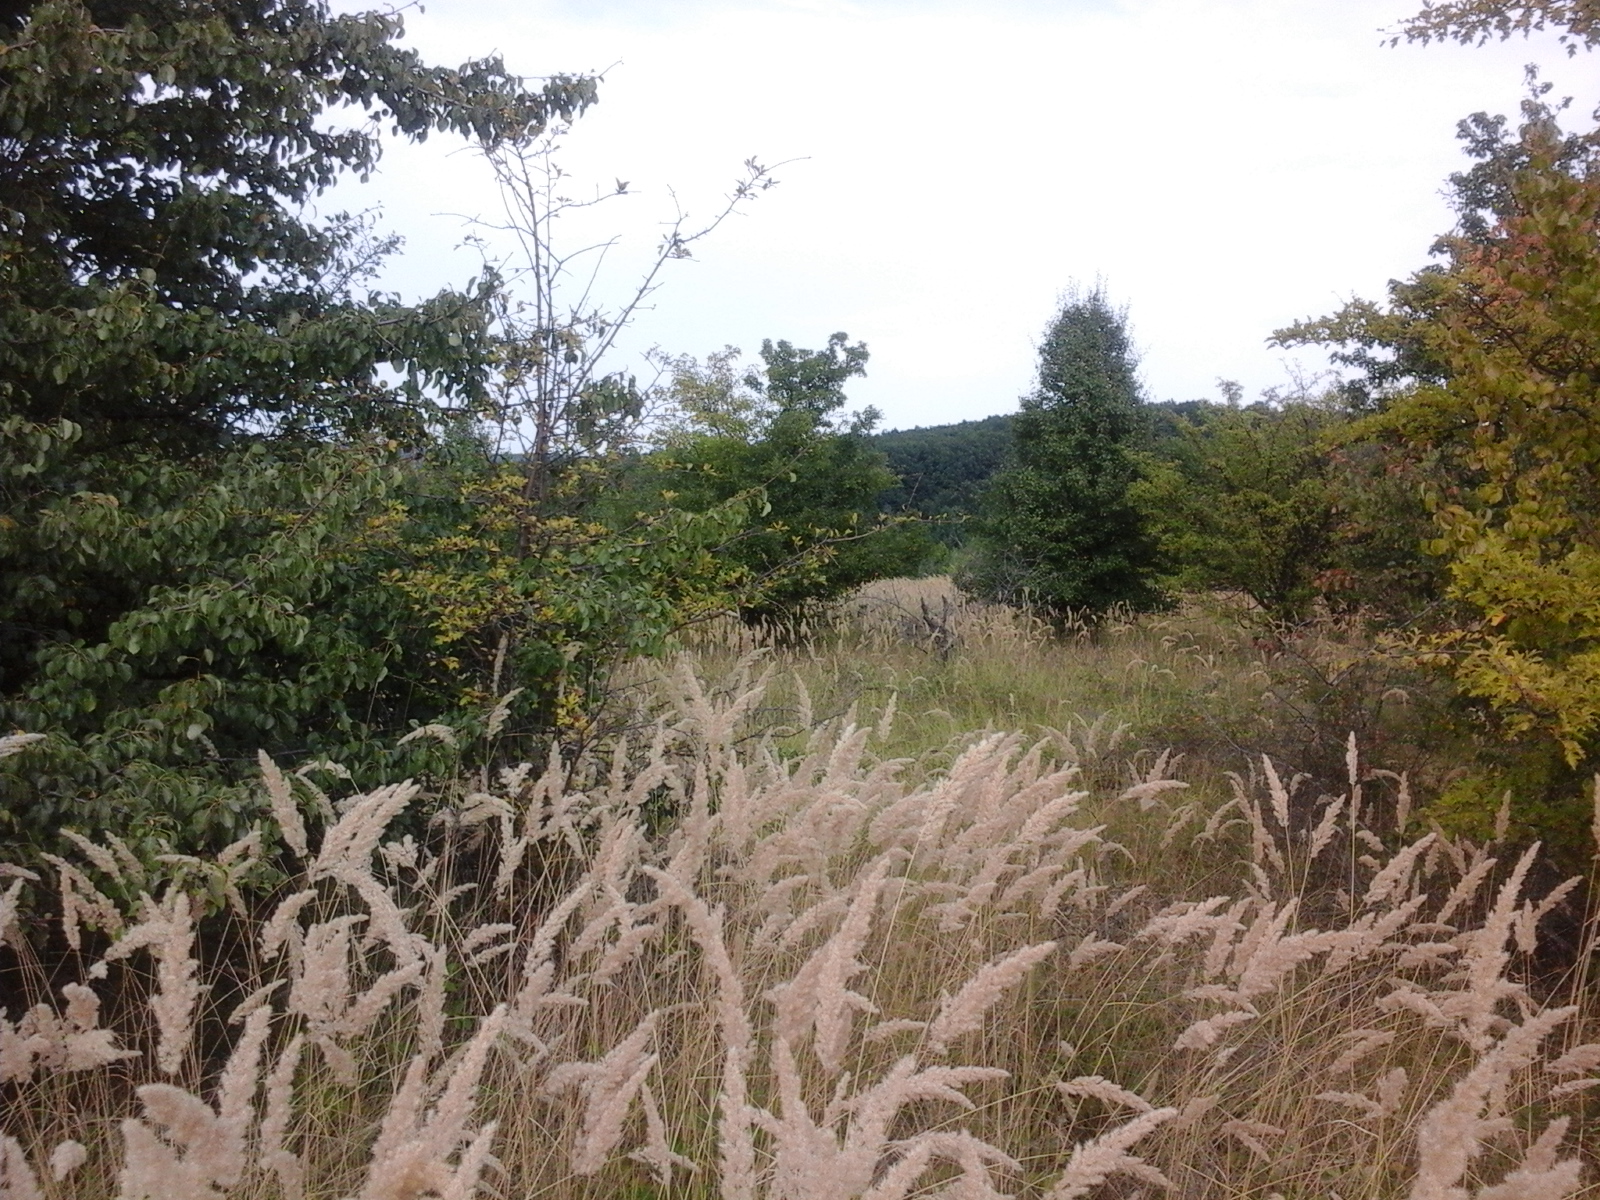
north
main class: Grassland
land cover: Spontaneously vegetated surfaces
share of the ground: > 75 %
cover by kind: herbaceous plants 100 %
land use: Agriculture (excluding fallow land and kitchen gardens)
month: August
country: RO
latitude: 44.5951
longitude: 23.3675
